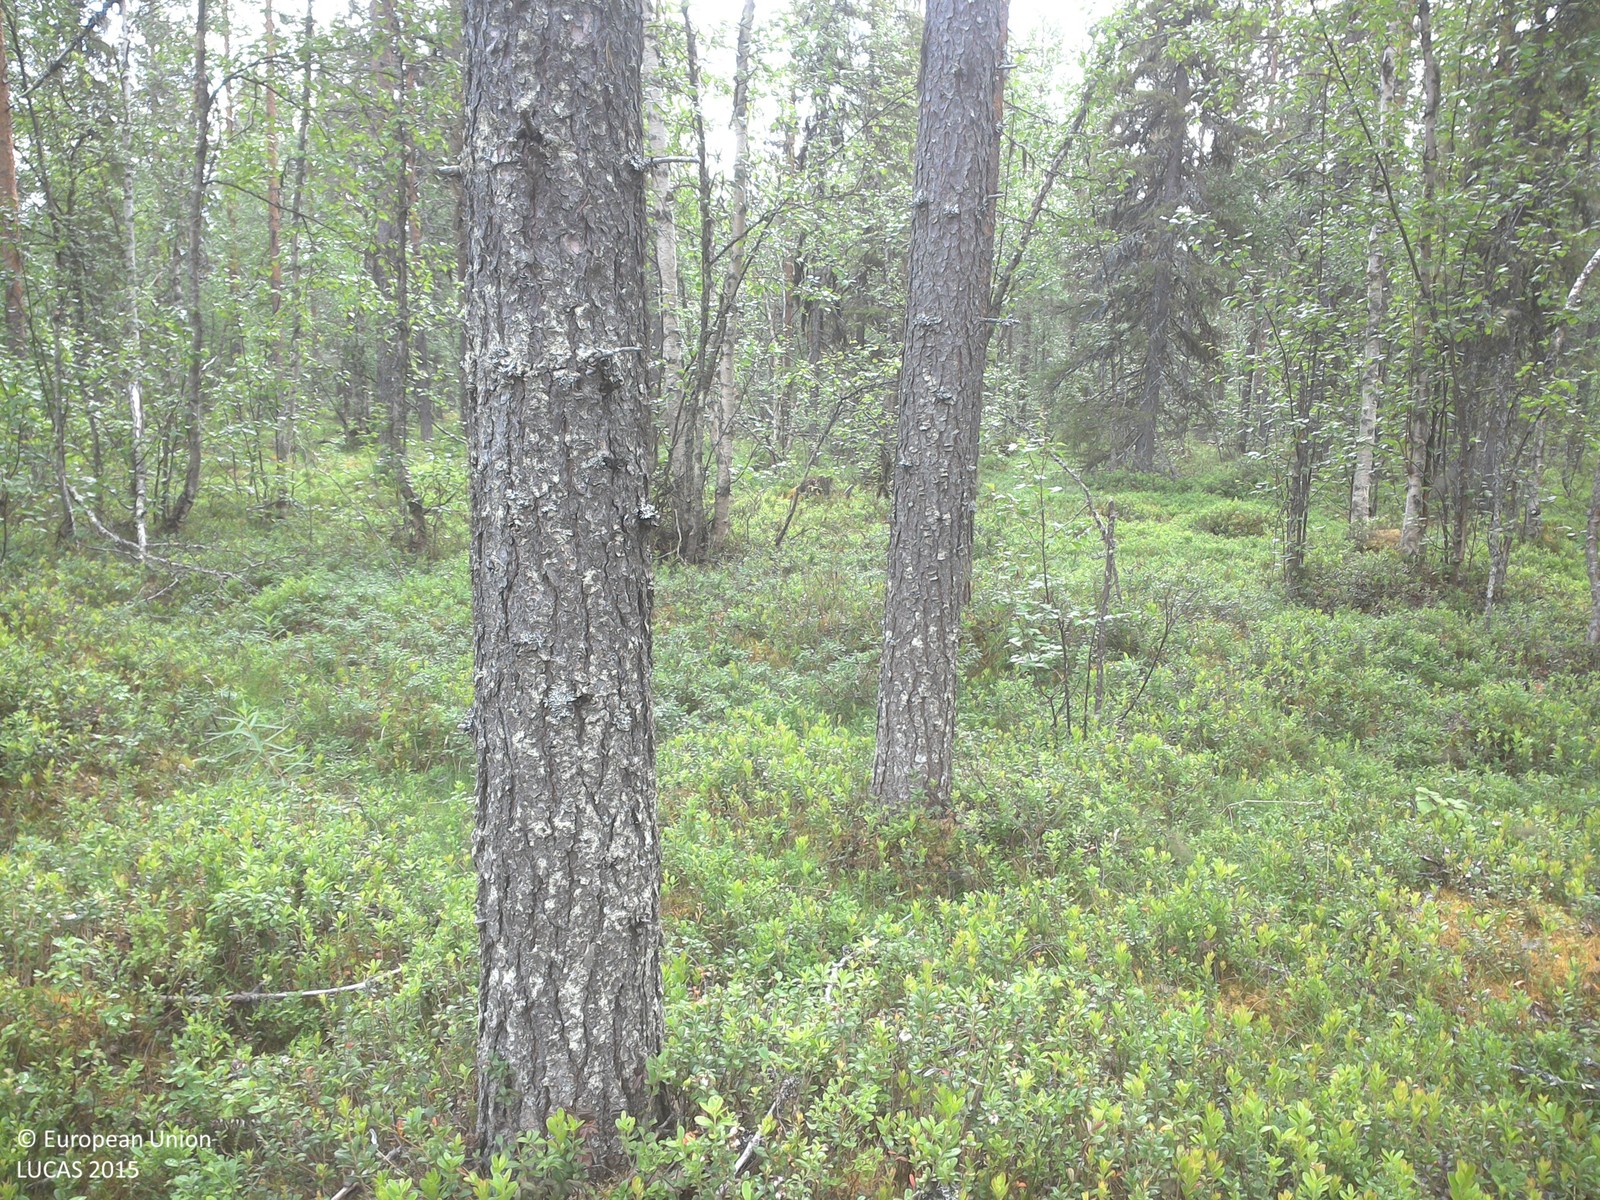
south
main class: Woodland
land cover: Pine dominated mixed woodland
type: boreal forest
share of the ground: 25 - 50 %
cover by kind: shrubs 55 %, coniferous forest trees 25 %, broadleaved forest trees 15 %, lichens and mosses 5 %
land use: Forestry
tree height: > 5 m
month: July
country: SE
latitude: 67.5909
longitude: 23.5313
